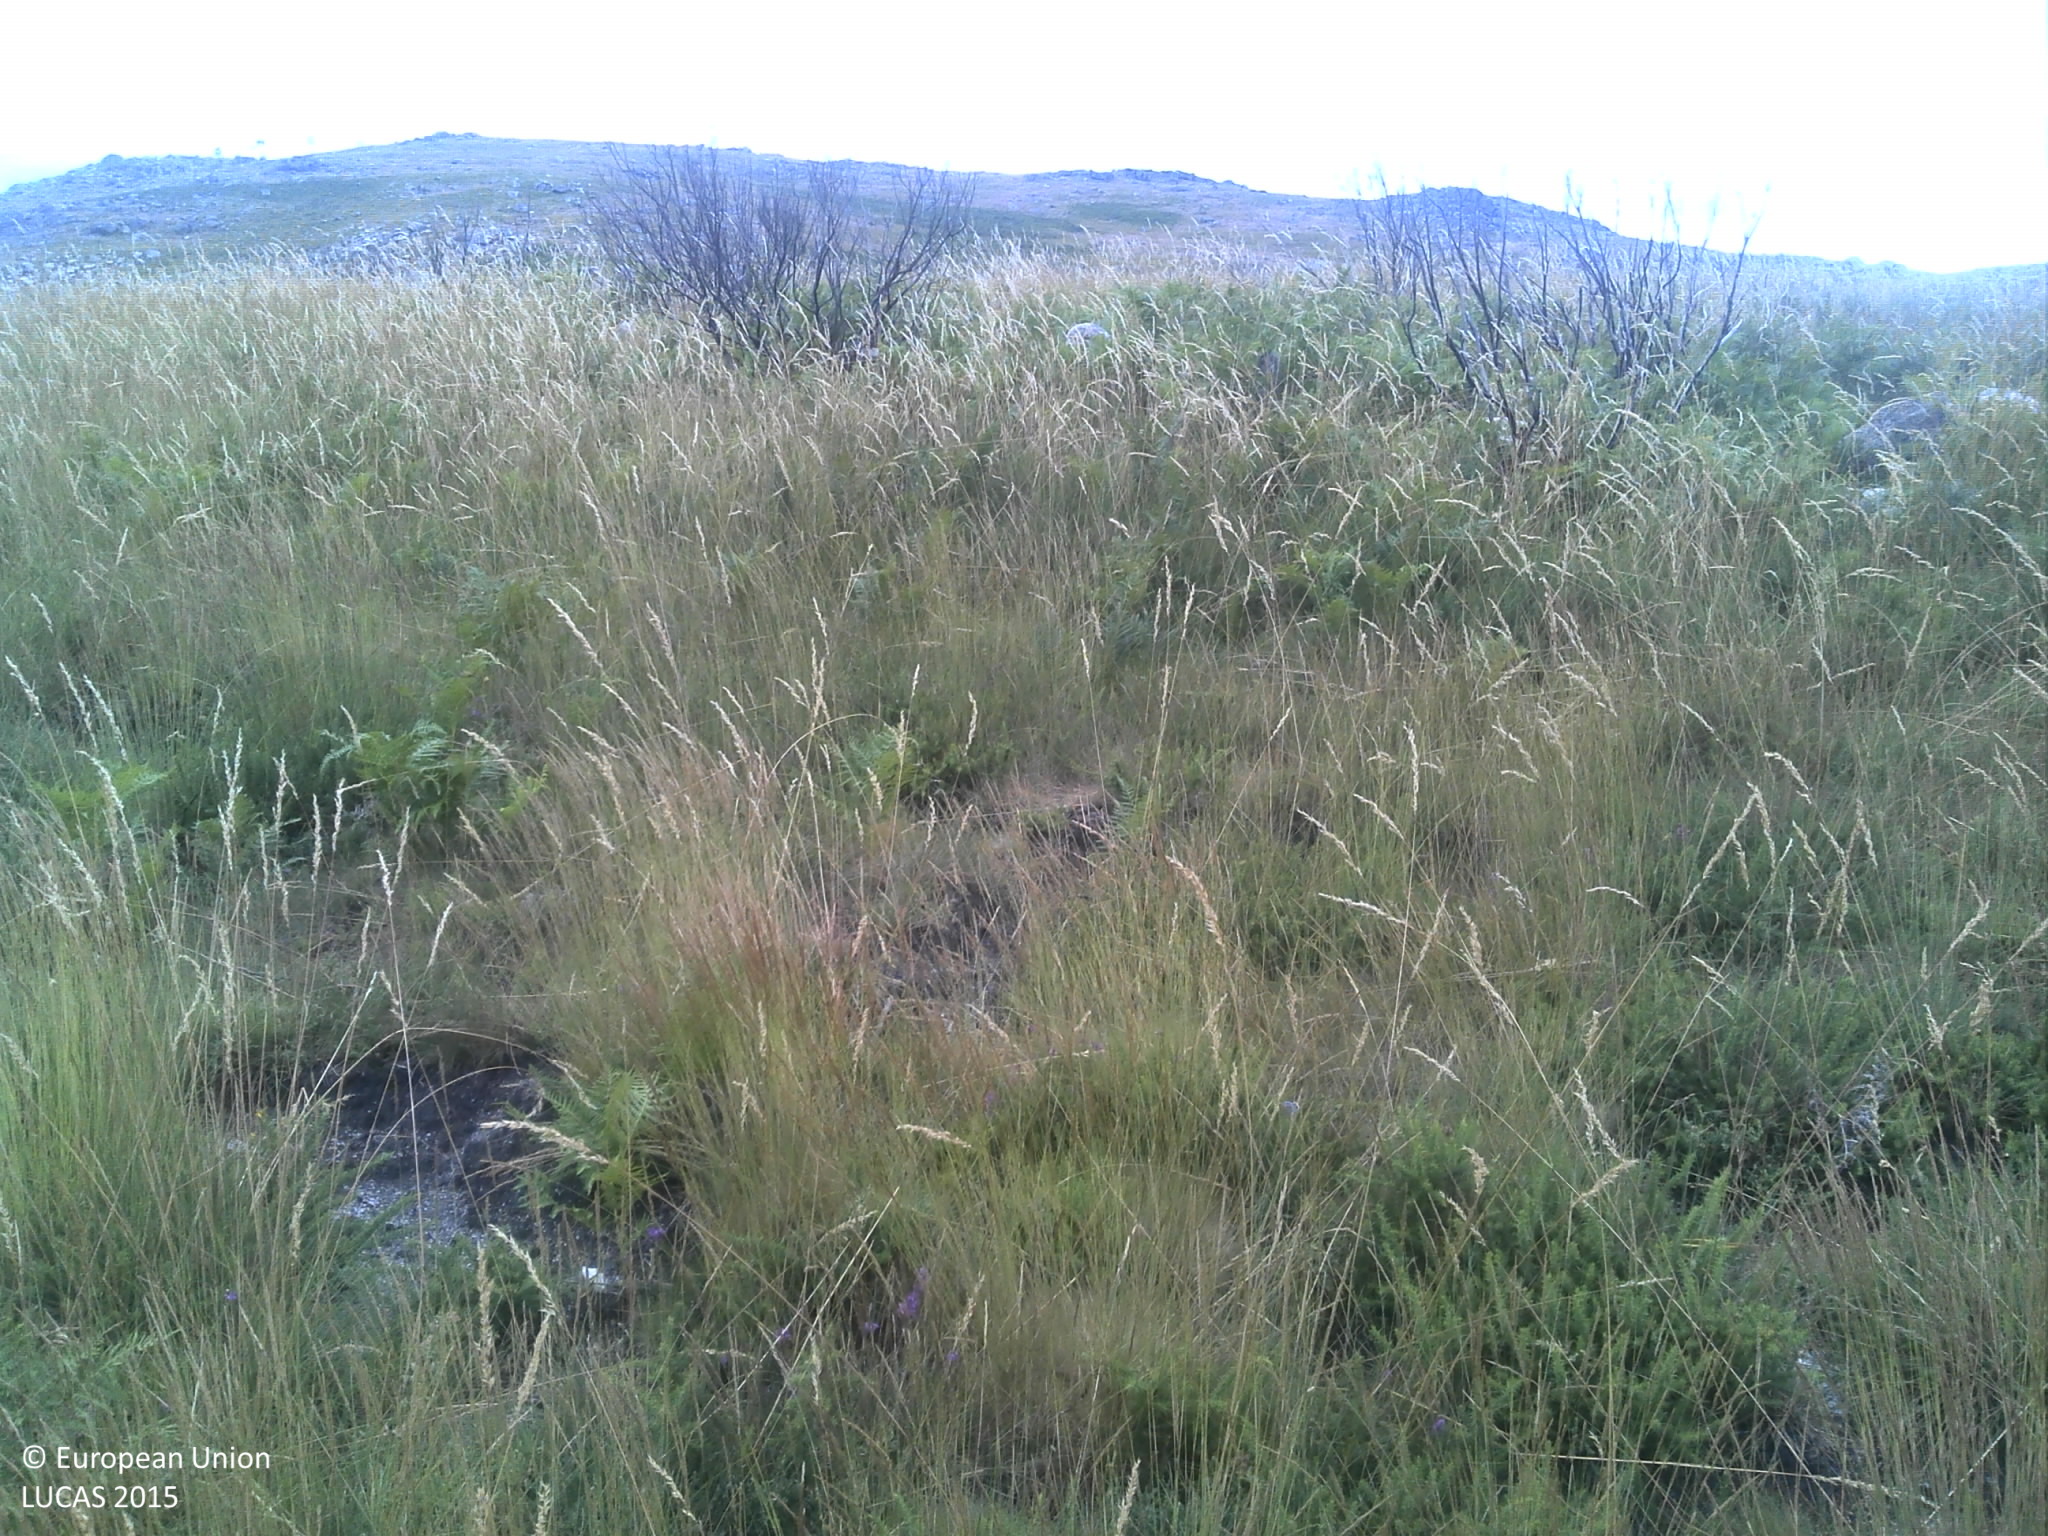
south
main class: Grassland
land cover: Grassland without tree/shrub cover
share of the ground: > 75 %
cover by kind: herbaceous plants 80 %, consolidated bare surface 10 %, shrubs 5 %, unconsolidated bare surface 5 %
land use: Agriculture (excluding fallow land and kitchen gardens)
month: July
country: PT
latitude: 41.3729
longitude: -7.8168
